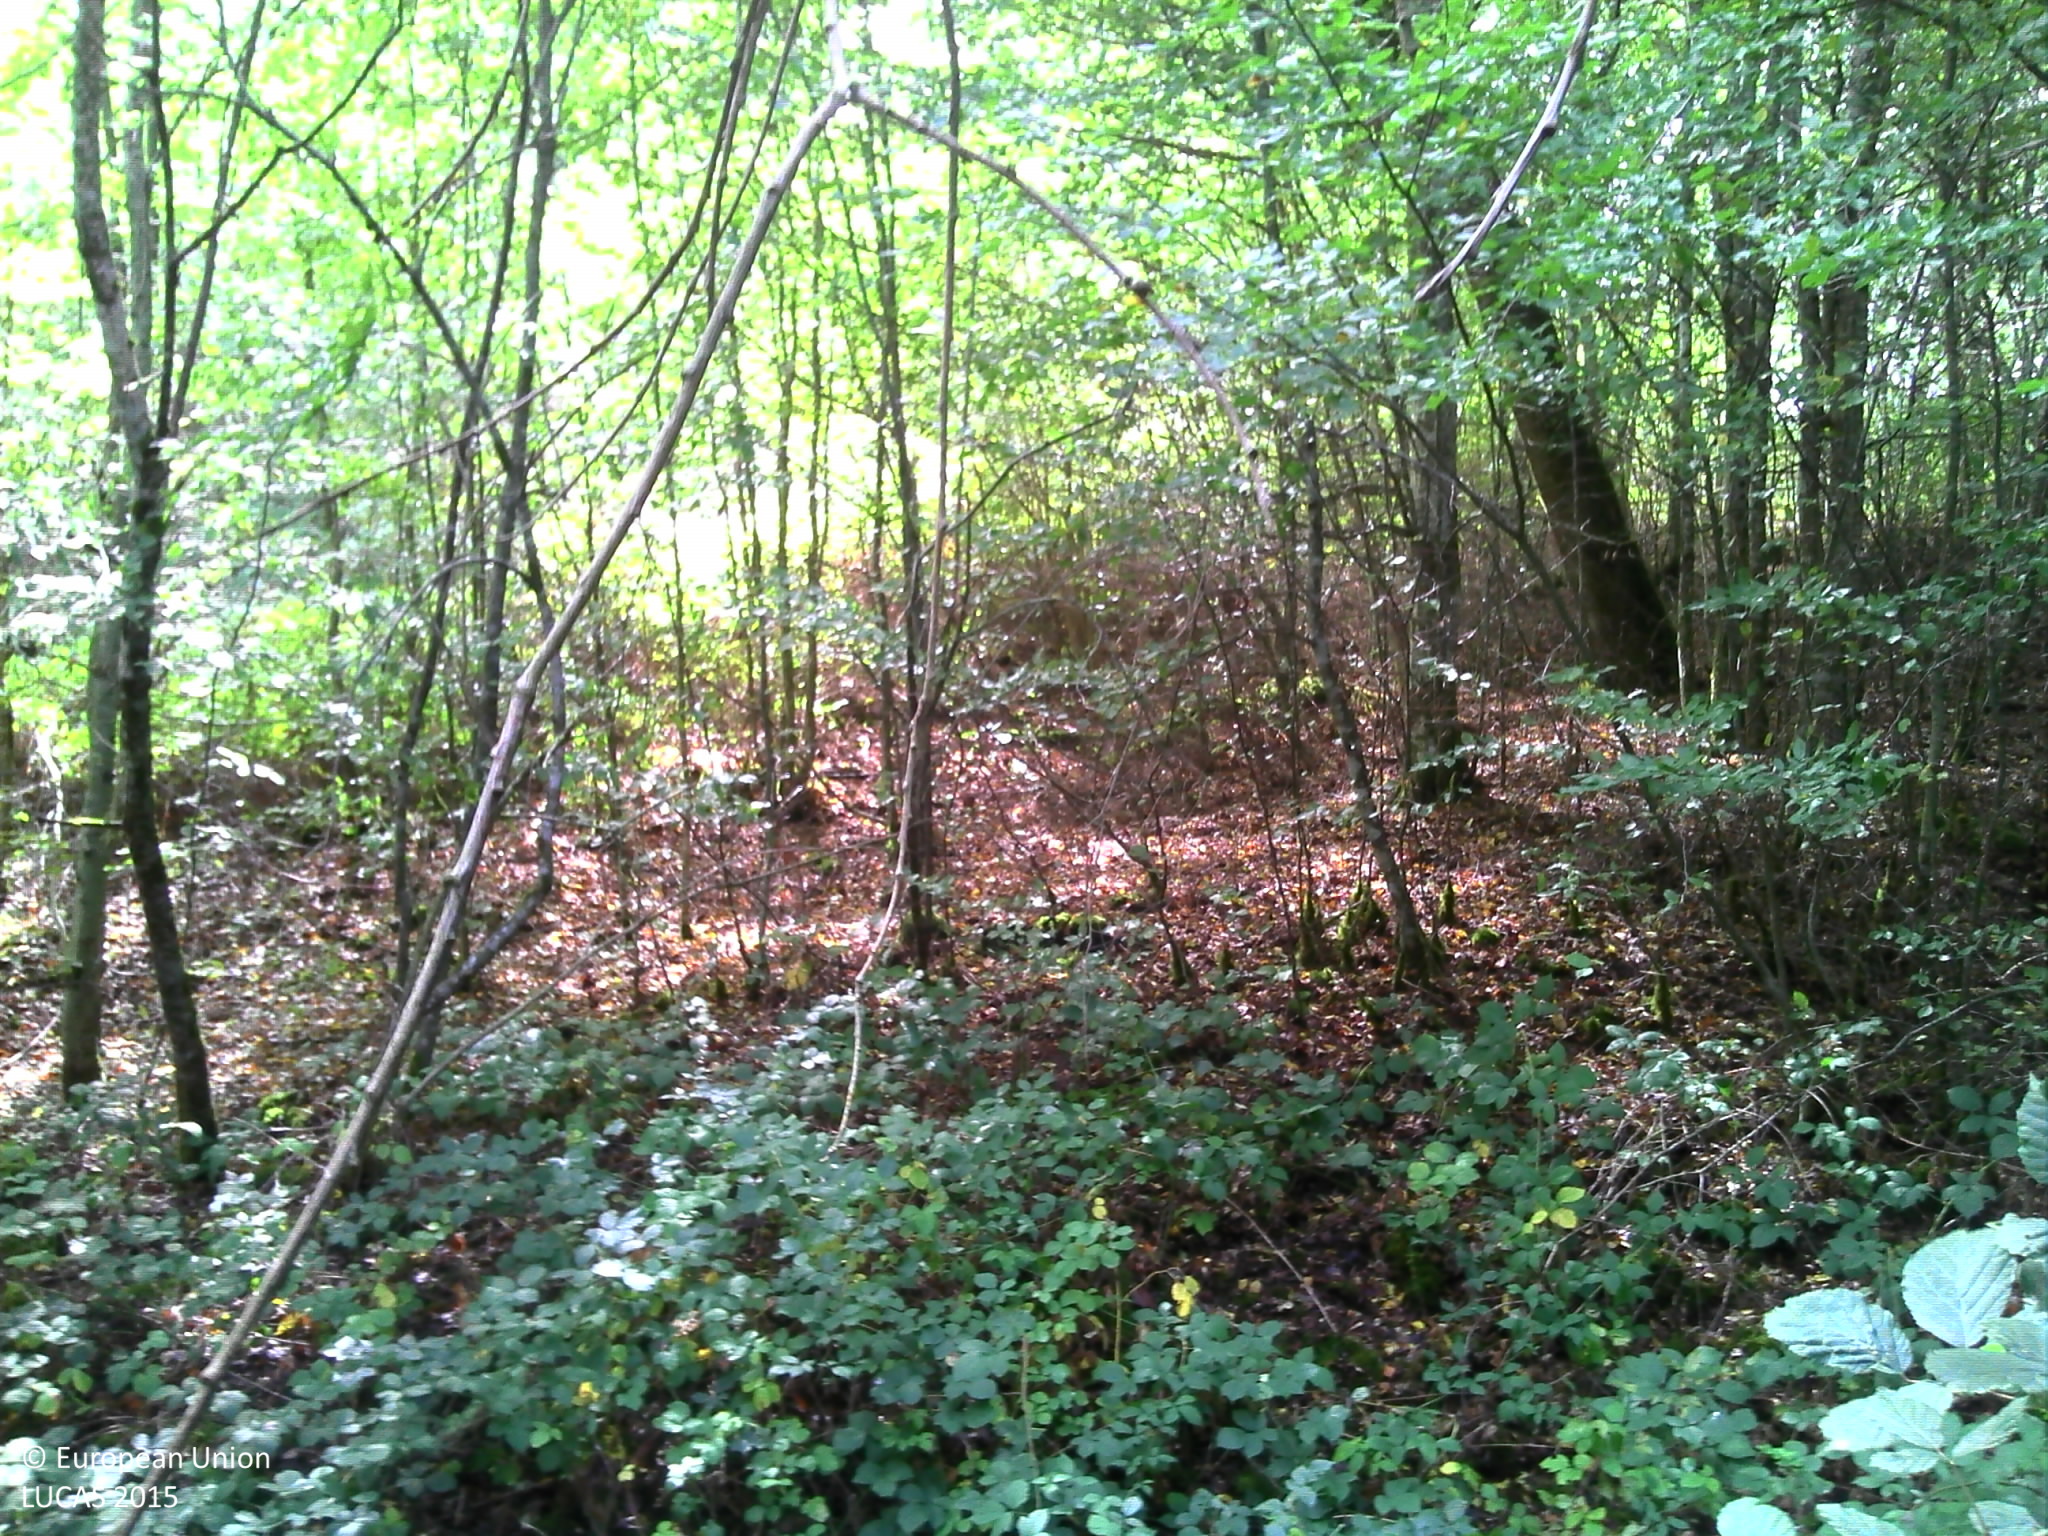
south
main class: Woodland
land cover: Broadleaved woodland
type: mesophytic deciduous forest
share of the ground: > 75 %
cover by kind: broadleaved forest trees 85 %, shrubs 15 %
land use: Forestry
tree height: > 5 m
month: September
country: FR
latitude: 47.3016
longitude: 4.3253
